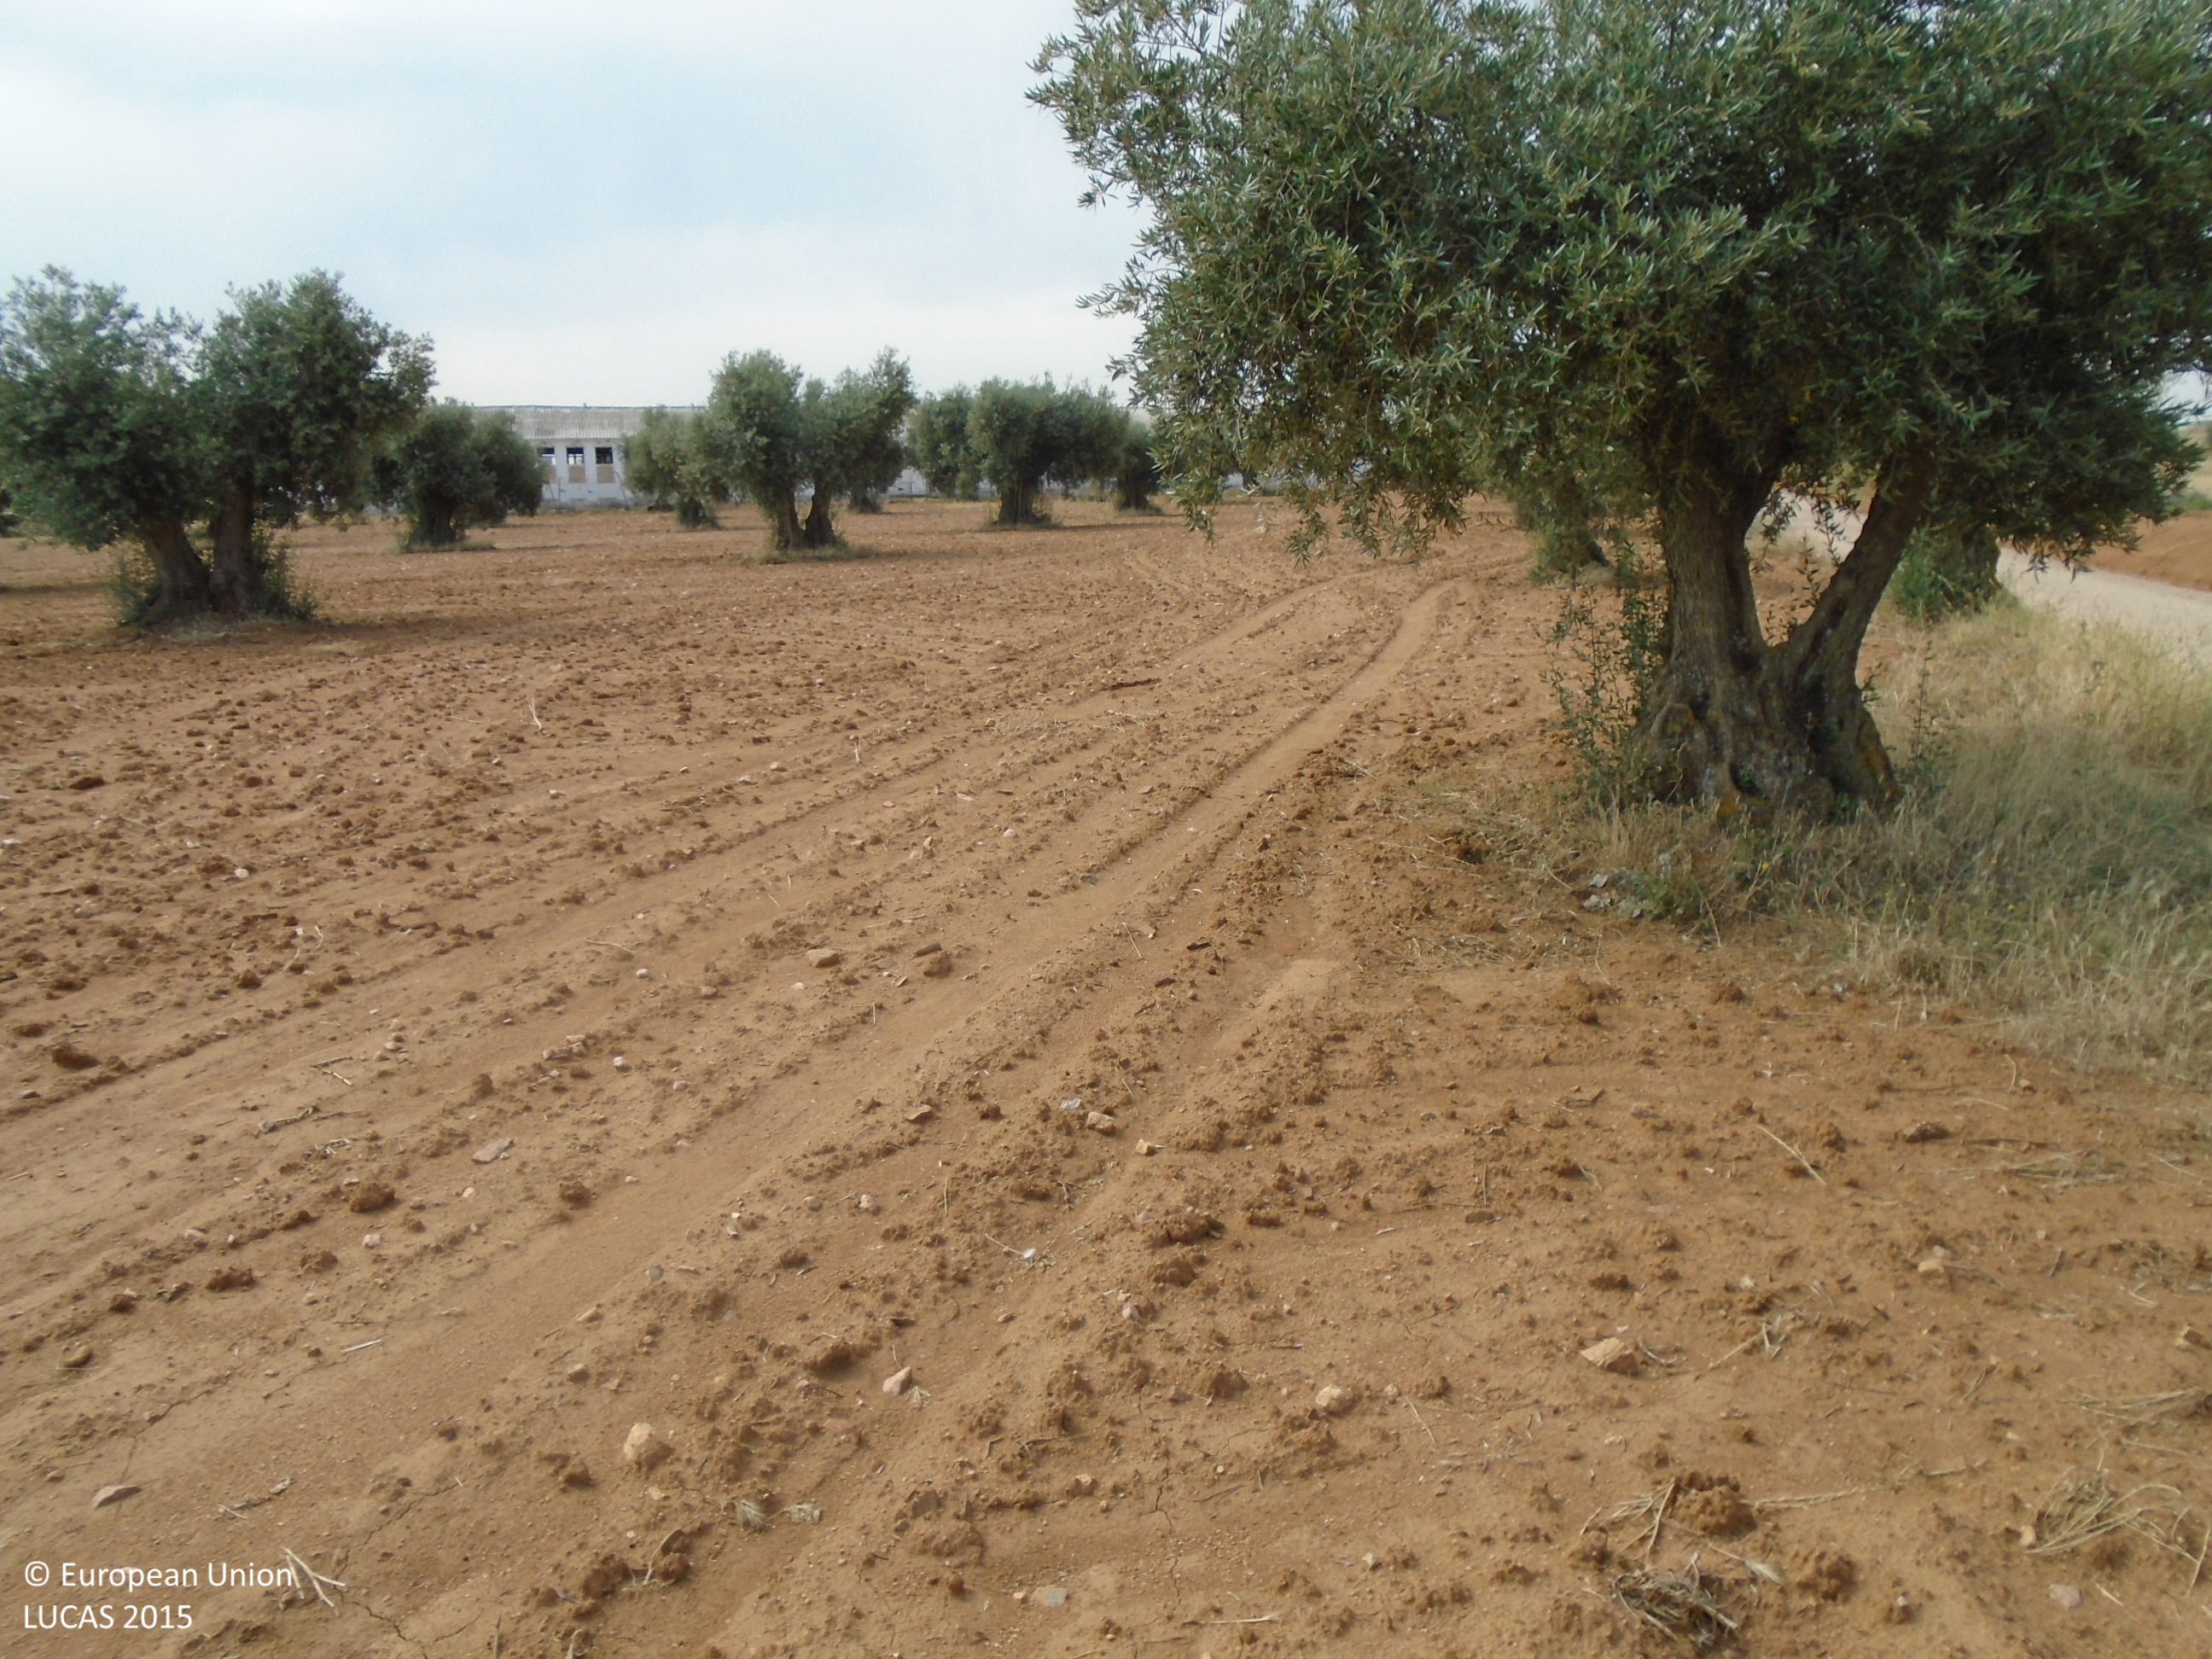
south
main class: Cropland
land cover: Olive groves
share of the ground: 10 - 25 %
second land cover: Other bare soil
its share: > 75 %
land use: Agriculture (excluding fallow land and kitchen gardens)
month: June
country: ES
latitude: 39.7647
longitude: -4.1714
